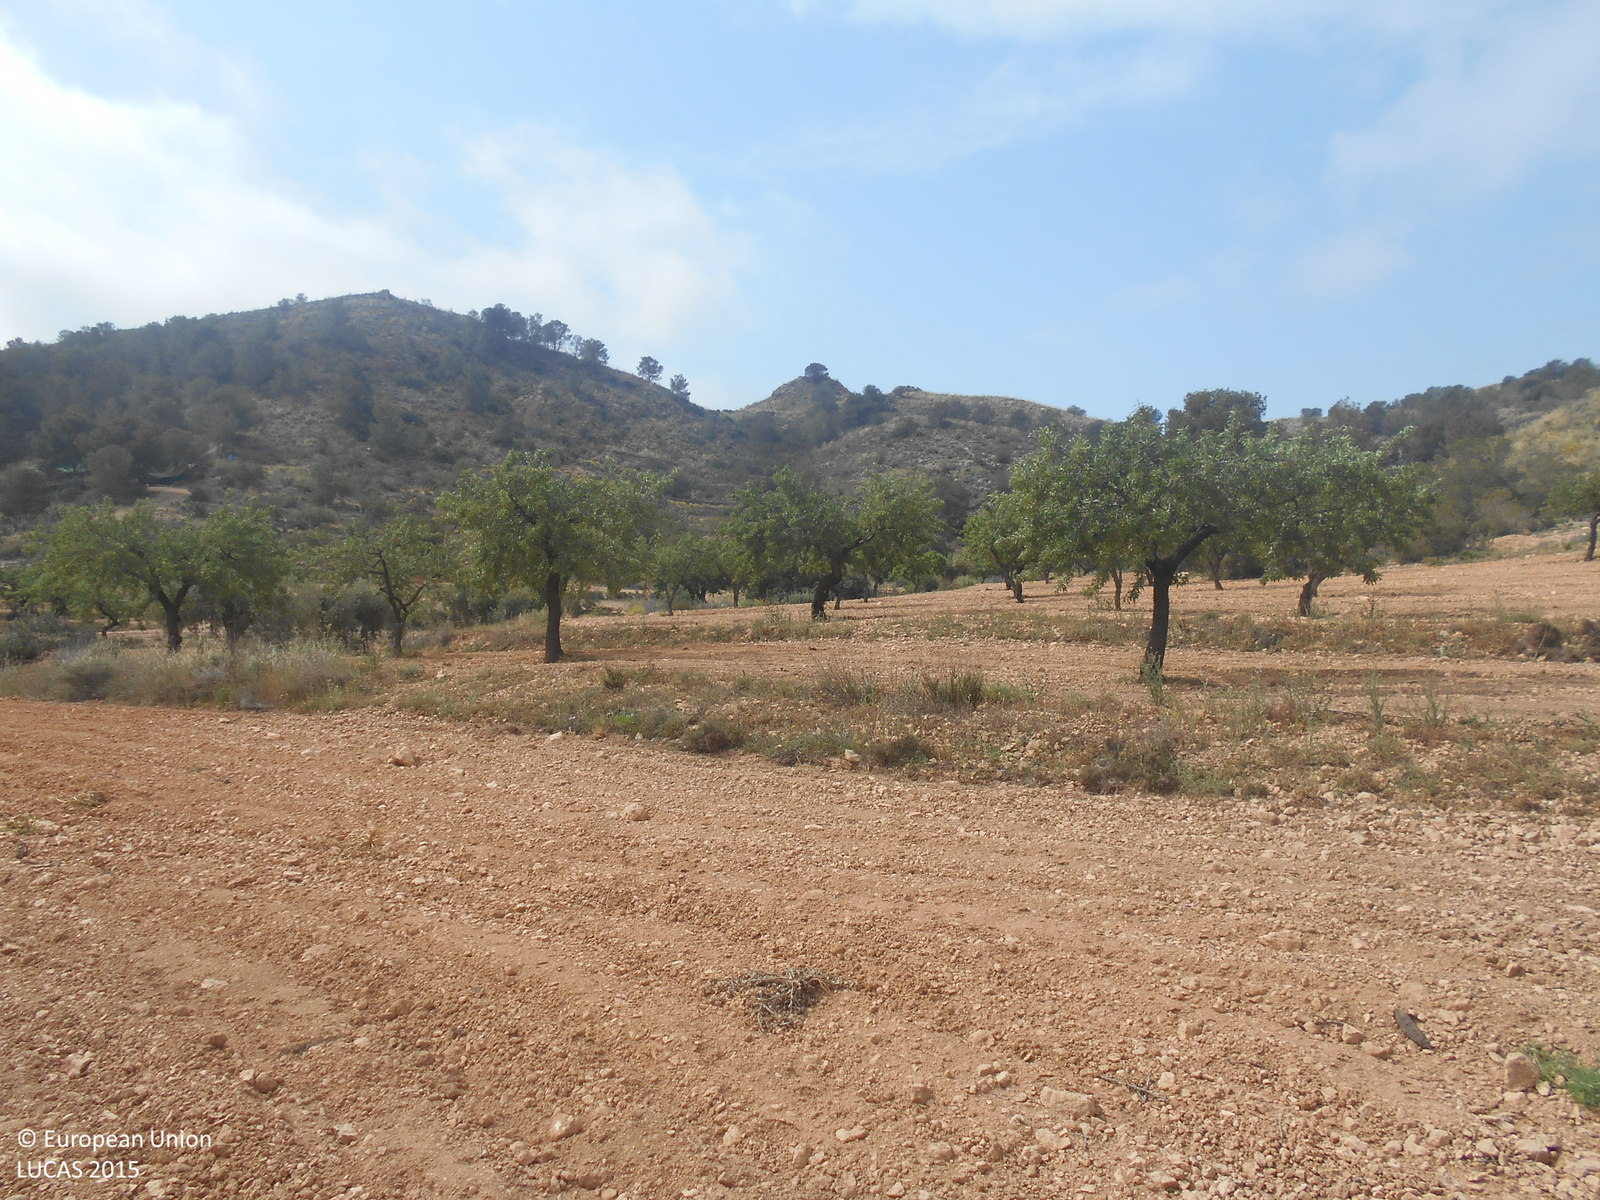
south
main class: Cropland
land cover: Nuts trees
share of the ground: 10 - 25 %
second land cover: Spontaneously vegetated surfaces
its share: 25 - 50 %
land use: Agriculture (excluding fallow land and kitchen gardens)
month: April
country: ES
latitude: 37.8108
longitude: -1.2387
